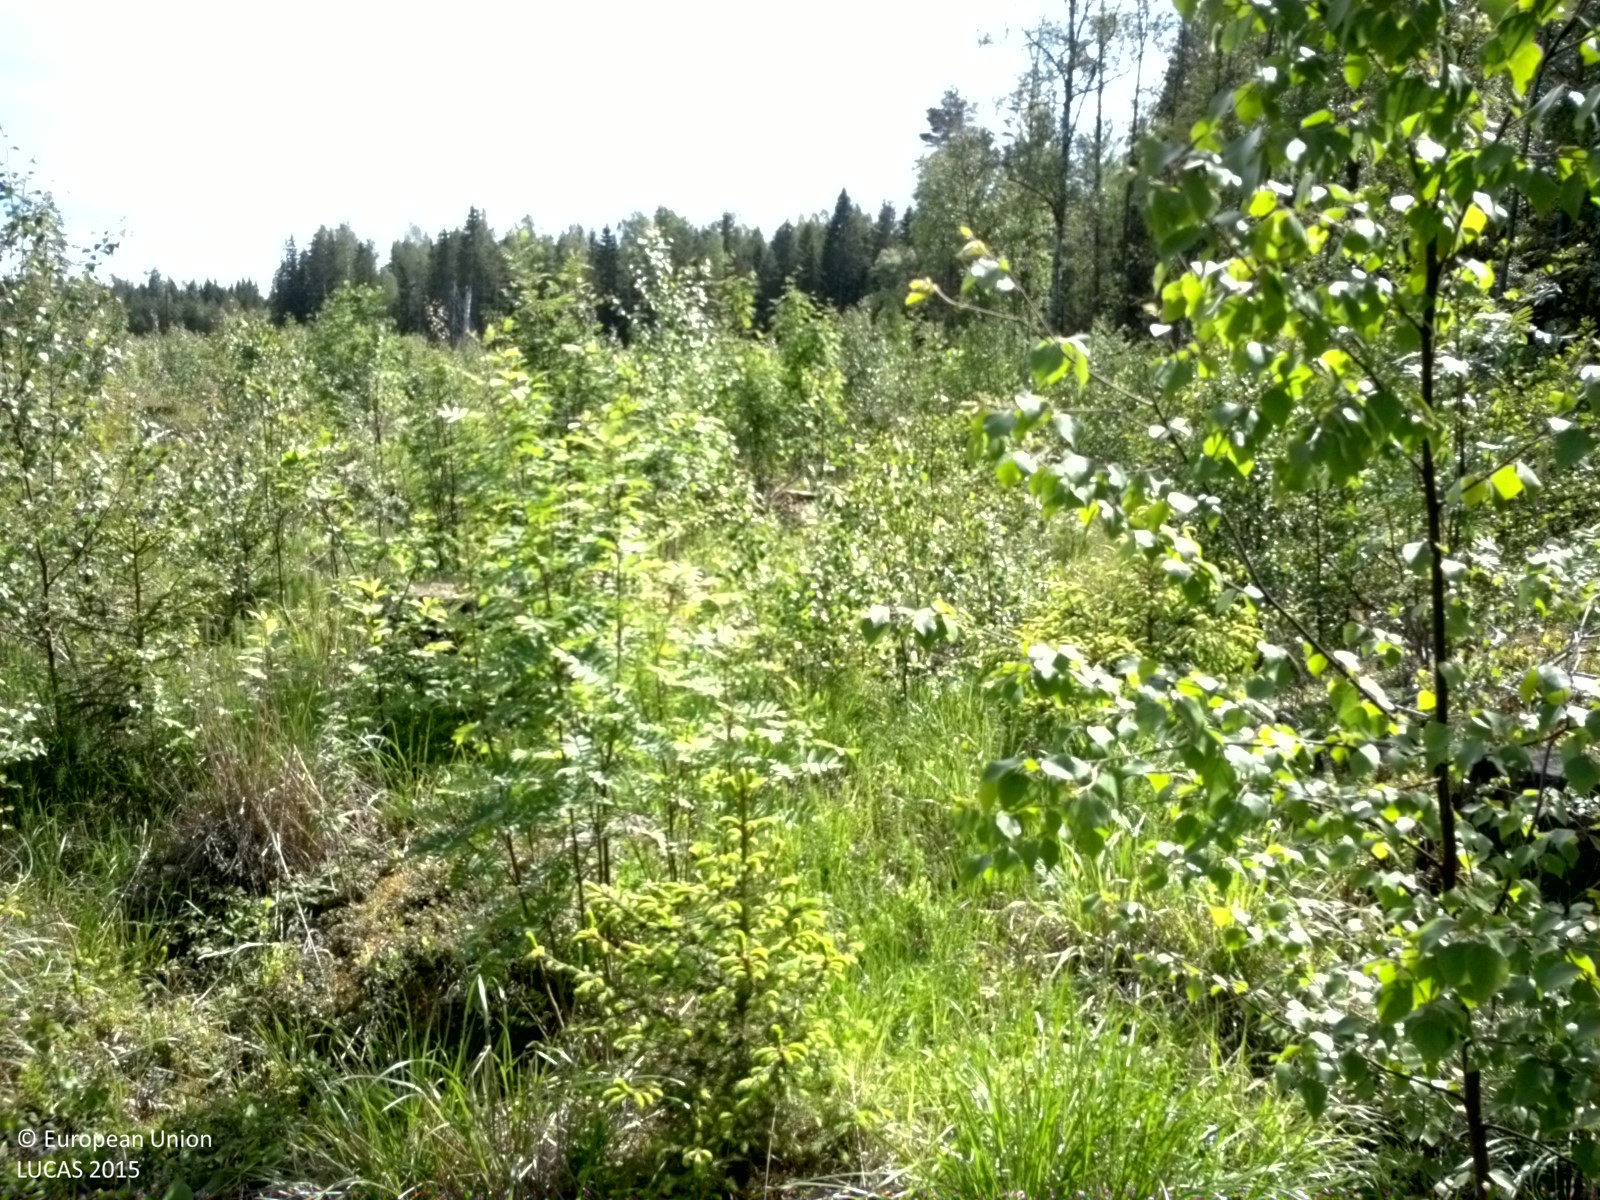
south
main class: Woodland
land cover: Broadleaved woodland
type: boreal forest
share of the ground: 50 - 75 %
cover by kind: broadleaved forest trees 50 %, herbaceous plants 30 %, coniferous forest trees 5 %, shrubs 5 %, lichens and mosses 5 %
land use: Forestry
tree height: < 5 m
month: June
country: SE
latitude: 60.3073
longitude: 17.1395
